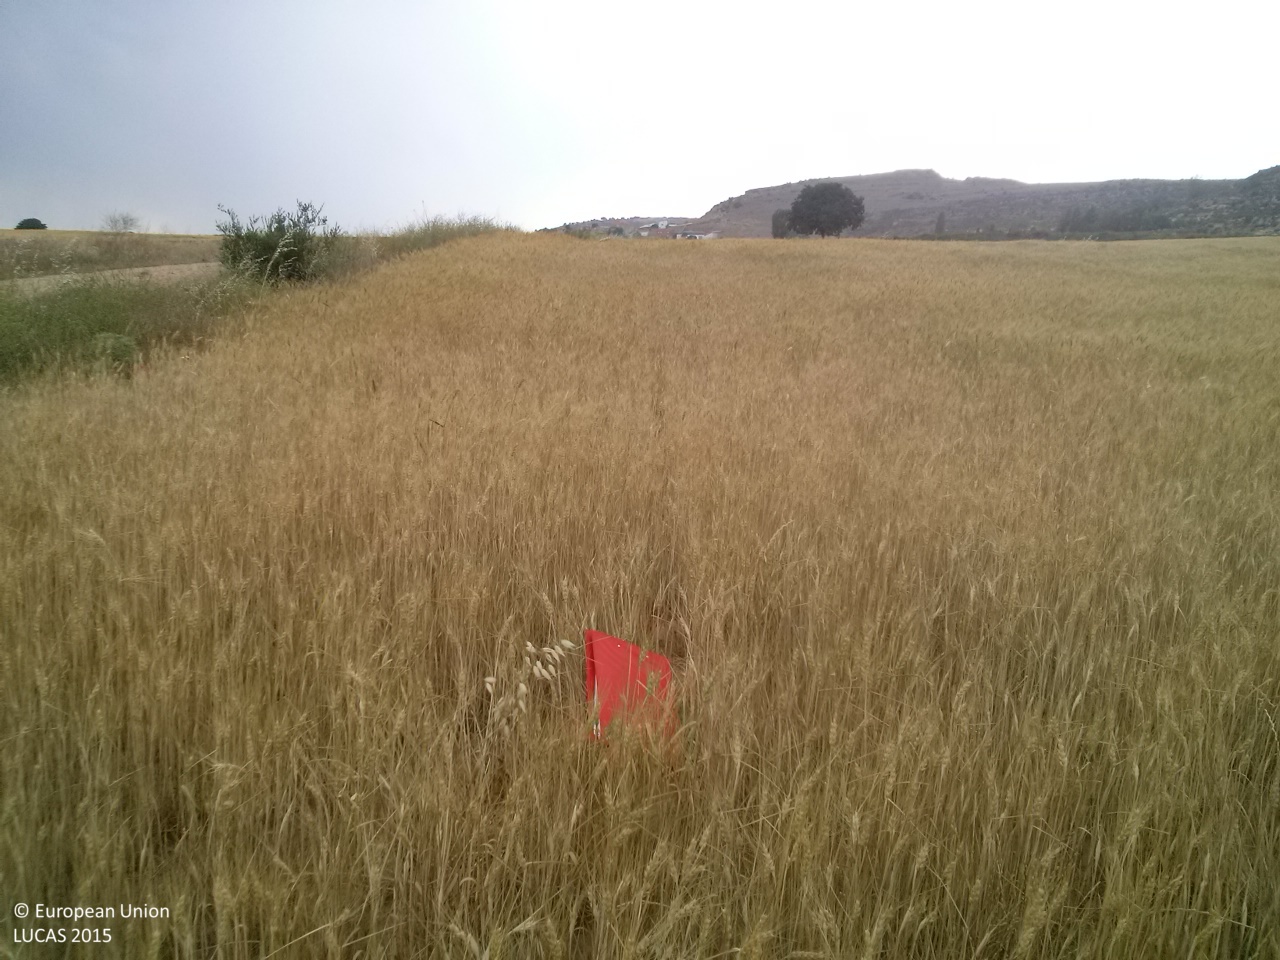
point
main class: Cropland
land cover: Barley
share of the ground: > 75 %
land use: Agriculture (excluding fallow land and kitchen gardens)
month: June
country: ES
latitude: 39.9104
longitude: -1.8616
